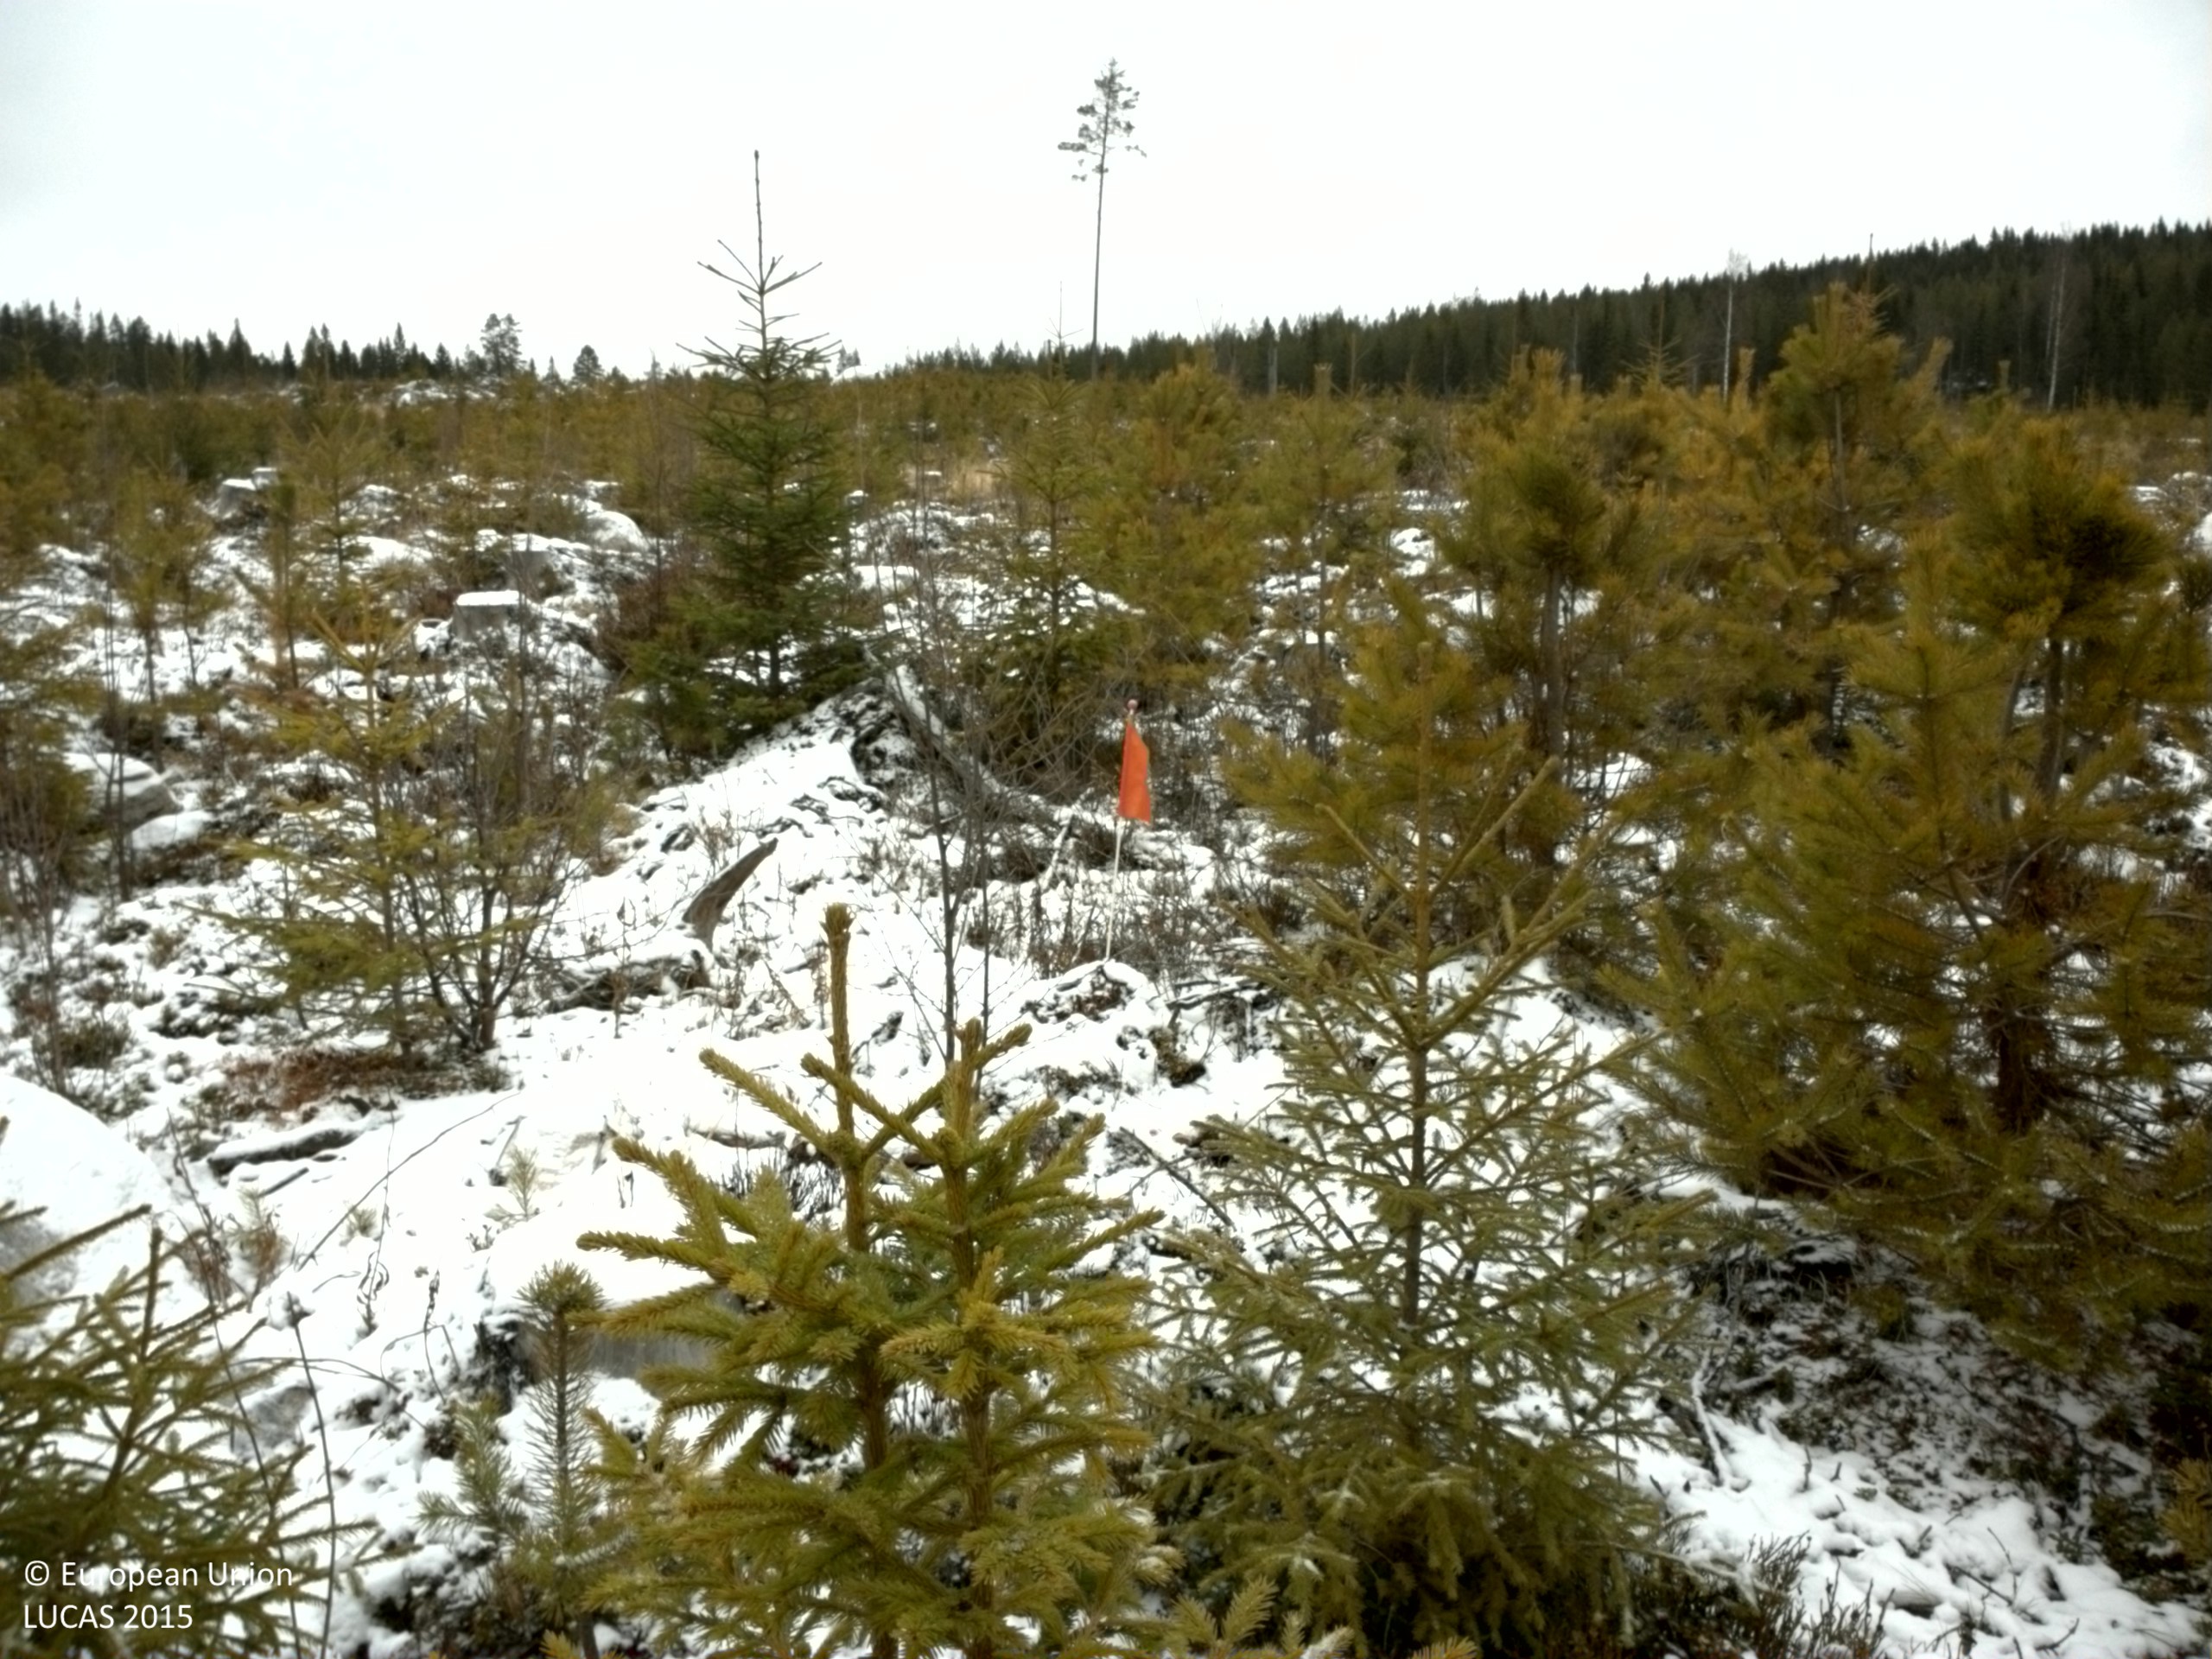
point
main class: Woodland
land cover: Other coniferous woodland
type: boreal forest
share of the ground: 25 - 50 %
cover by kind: shrubs 45 %, coniferous forest trees 25 %, lichens and mosses 20 %, broadleaved forest trees 5 %, consolidated bare surface 5 %
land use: Forestry
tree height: < 5 m
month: November
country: SE
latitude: 61.7668
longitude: 15.6107
